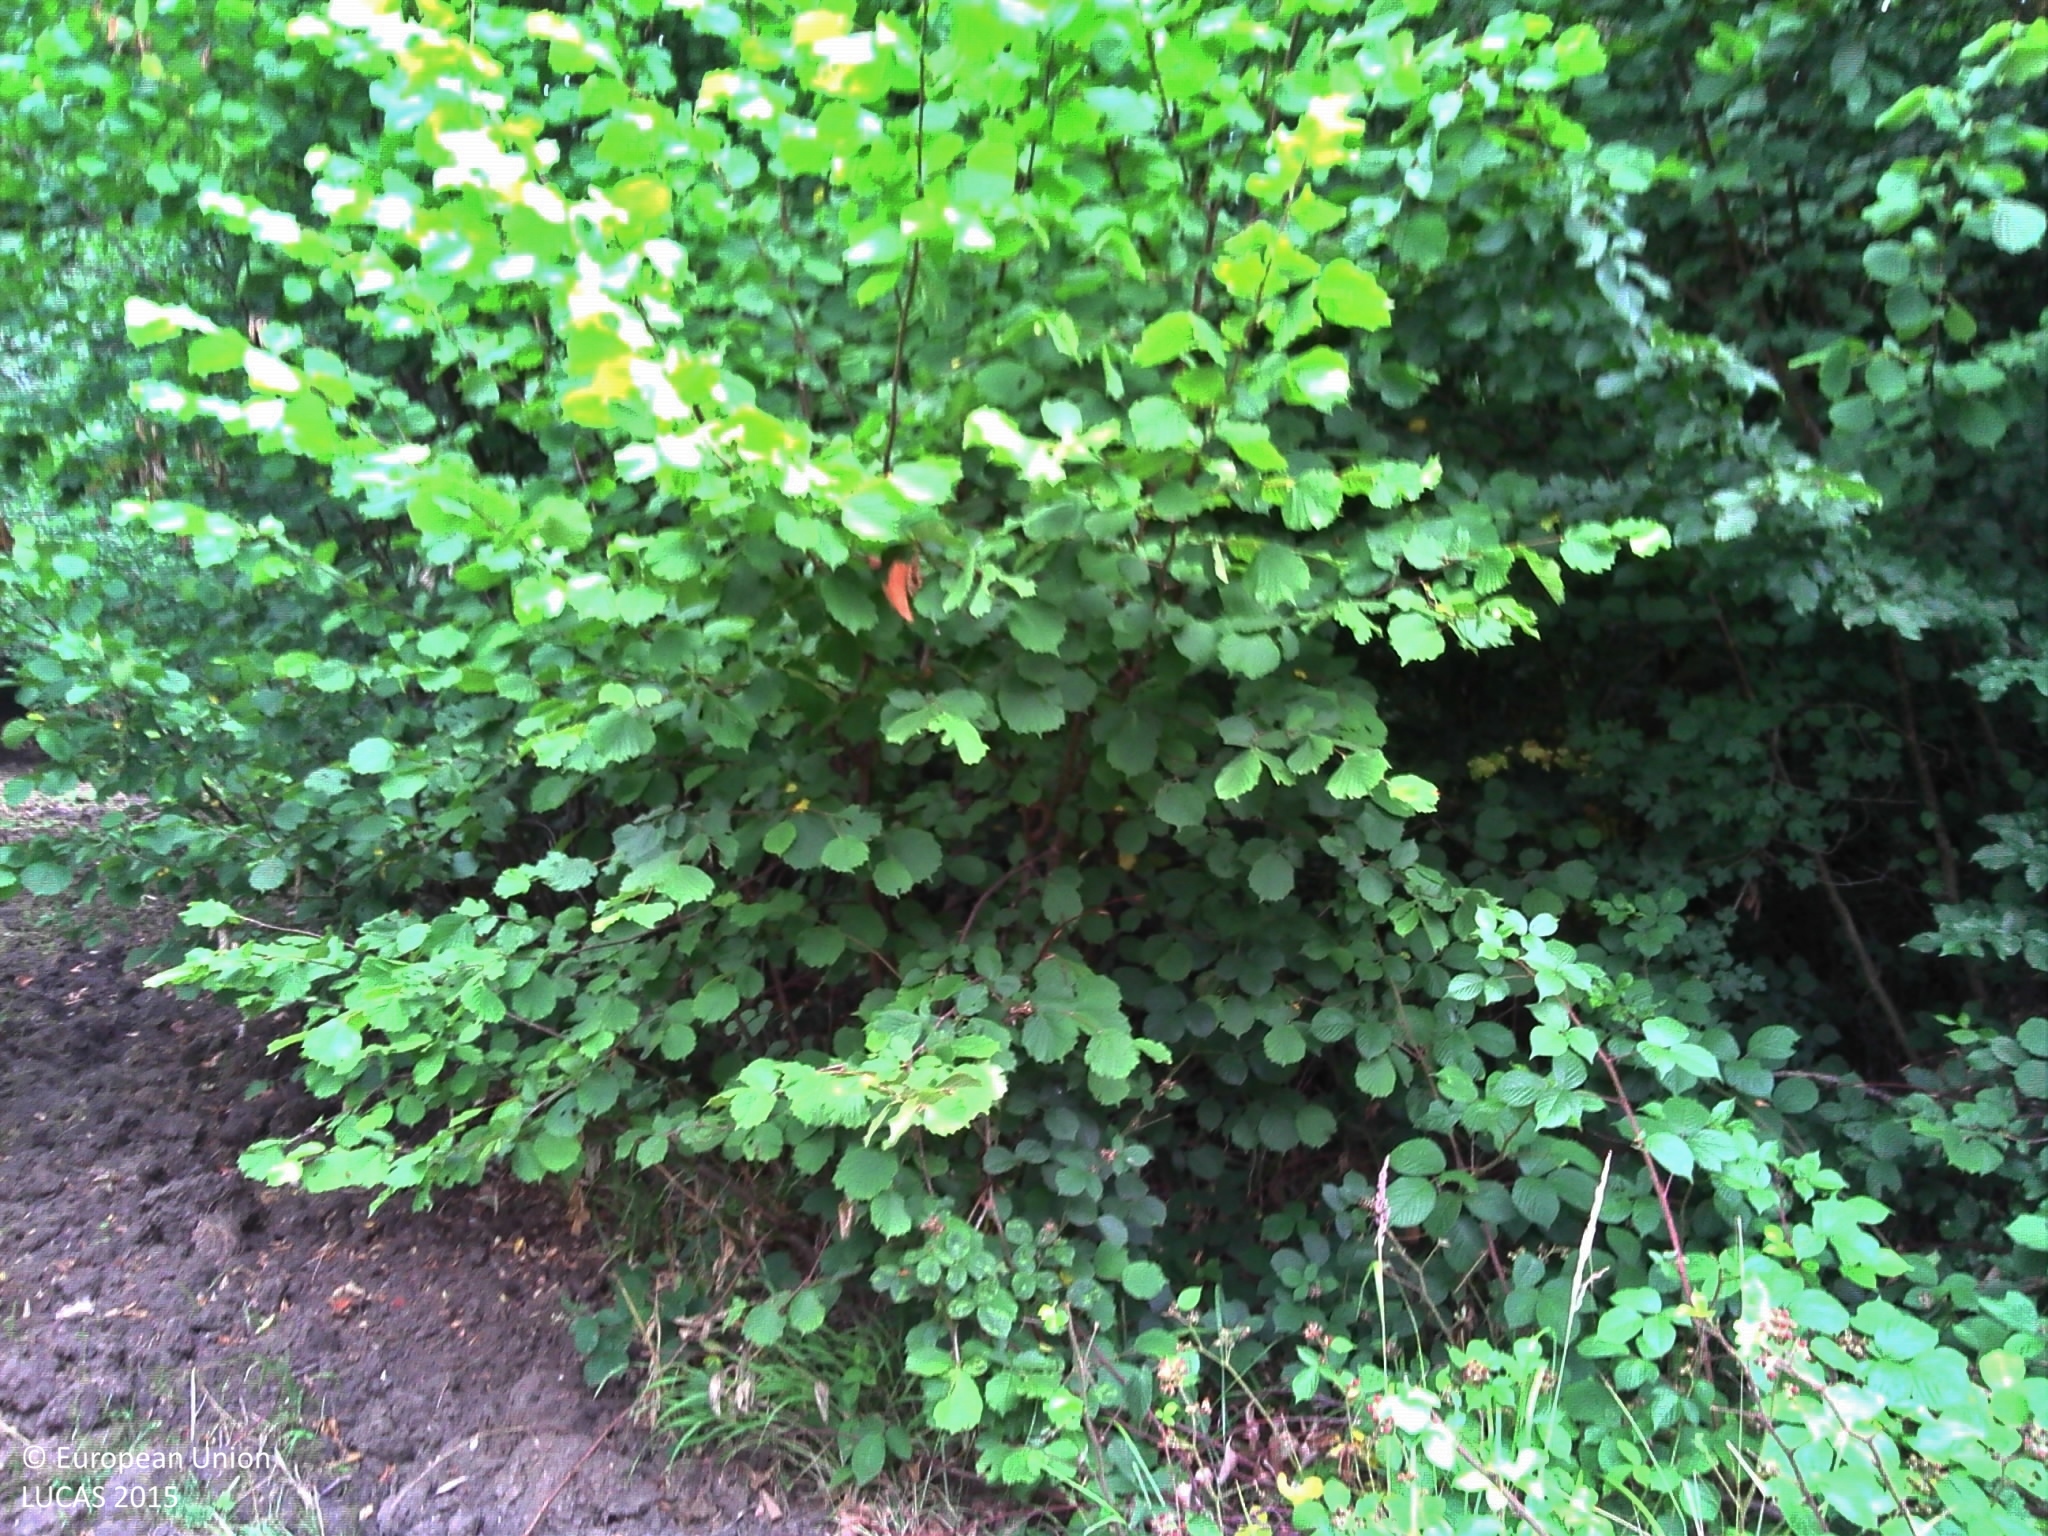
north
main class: Woodland
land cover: Broadleaved woodland
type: acidophilous oak and oak-birch forest
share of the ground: > 75 %
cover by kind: broadleaved forest trees 80 %, shrubs 15 %, herbaceous plants 5 %
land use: Forestry
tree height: > 5 m
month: July
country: FR
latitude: 49.2365
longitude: 2.5584
